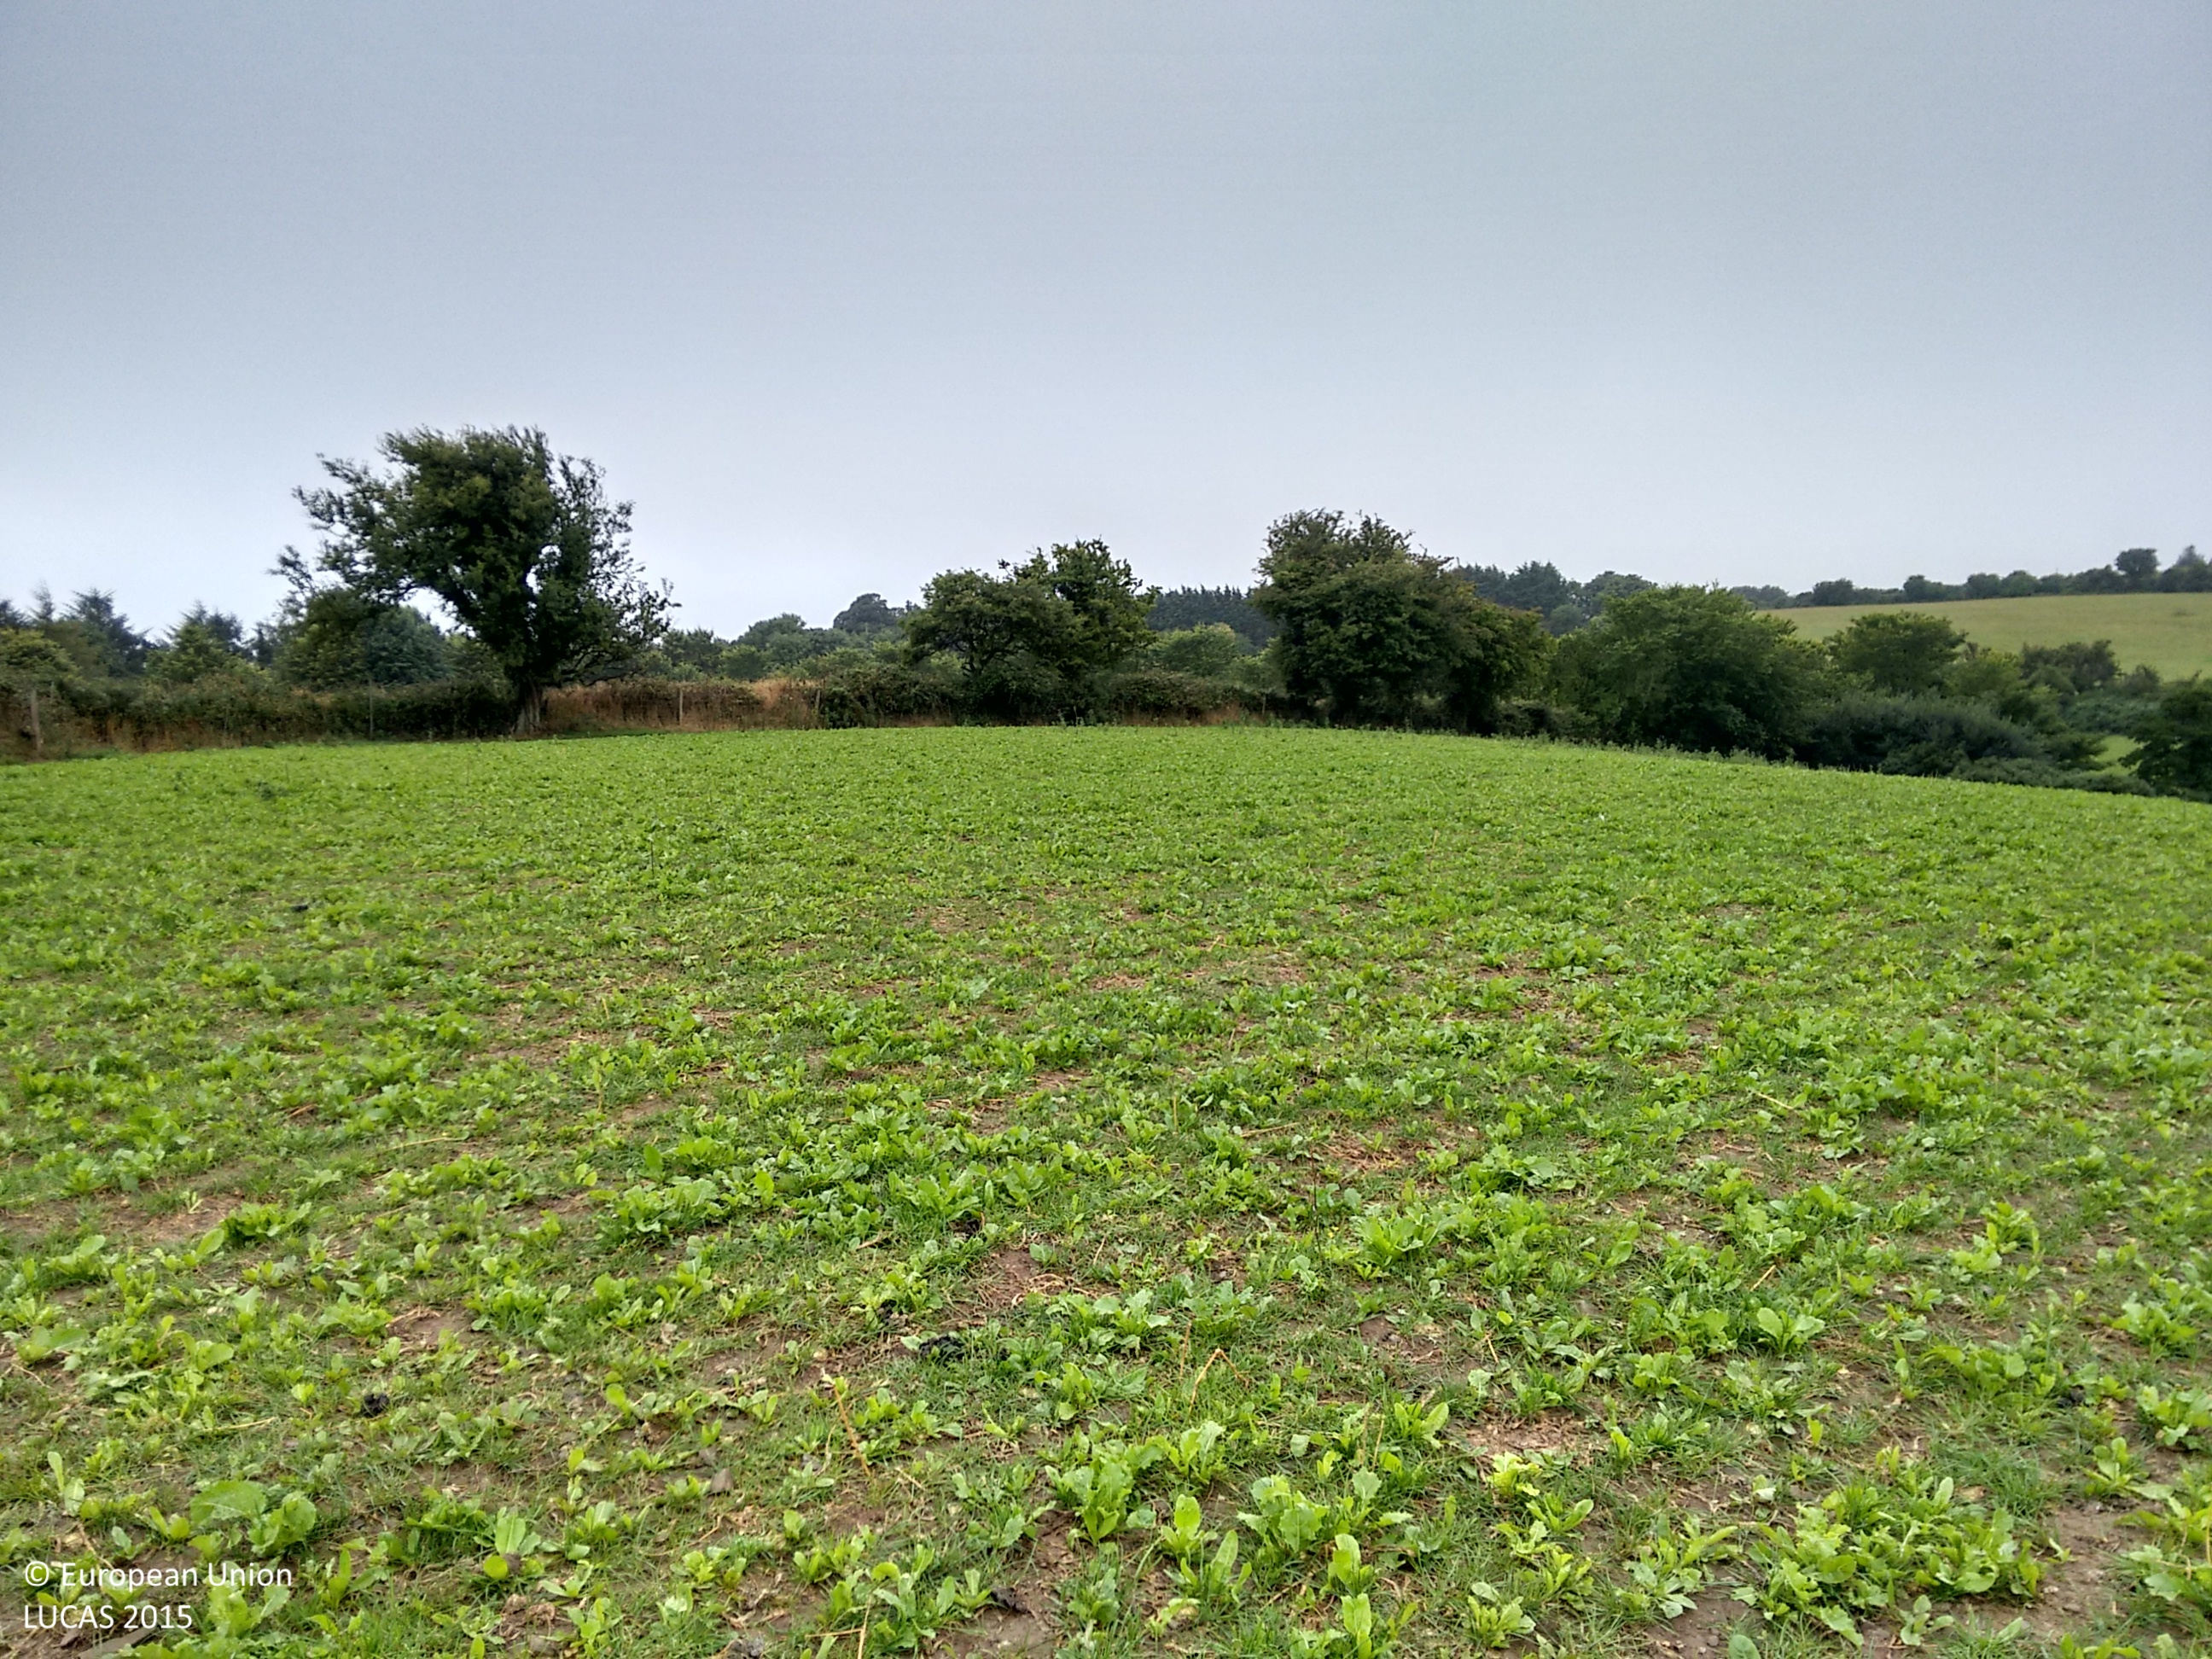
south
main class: Grassland
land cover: Spontaneously vegetated surfaces
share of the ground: > 75 %
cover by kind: herbaceous plants 80 %, unconsolidated bare surface 20 %
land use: Agriculture (excluding fallow land and kitchen gardens)
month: August
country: IE
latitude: 52.4916
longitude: -6.2779
